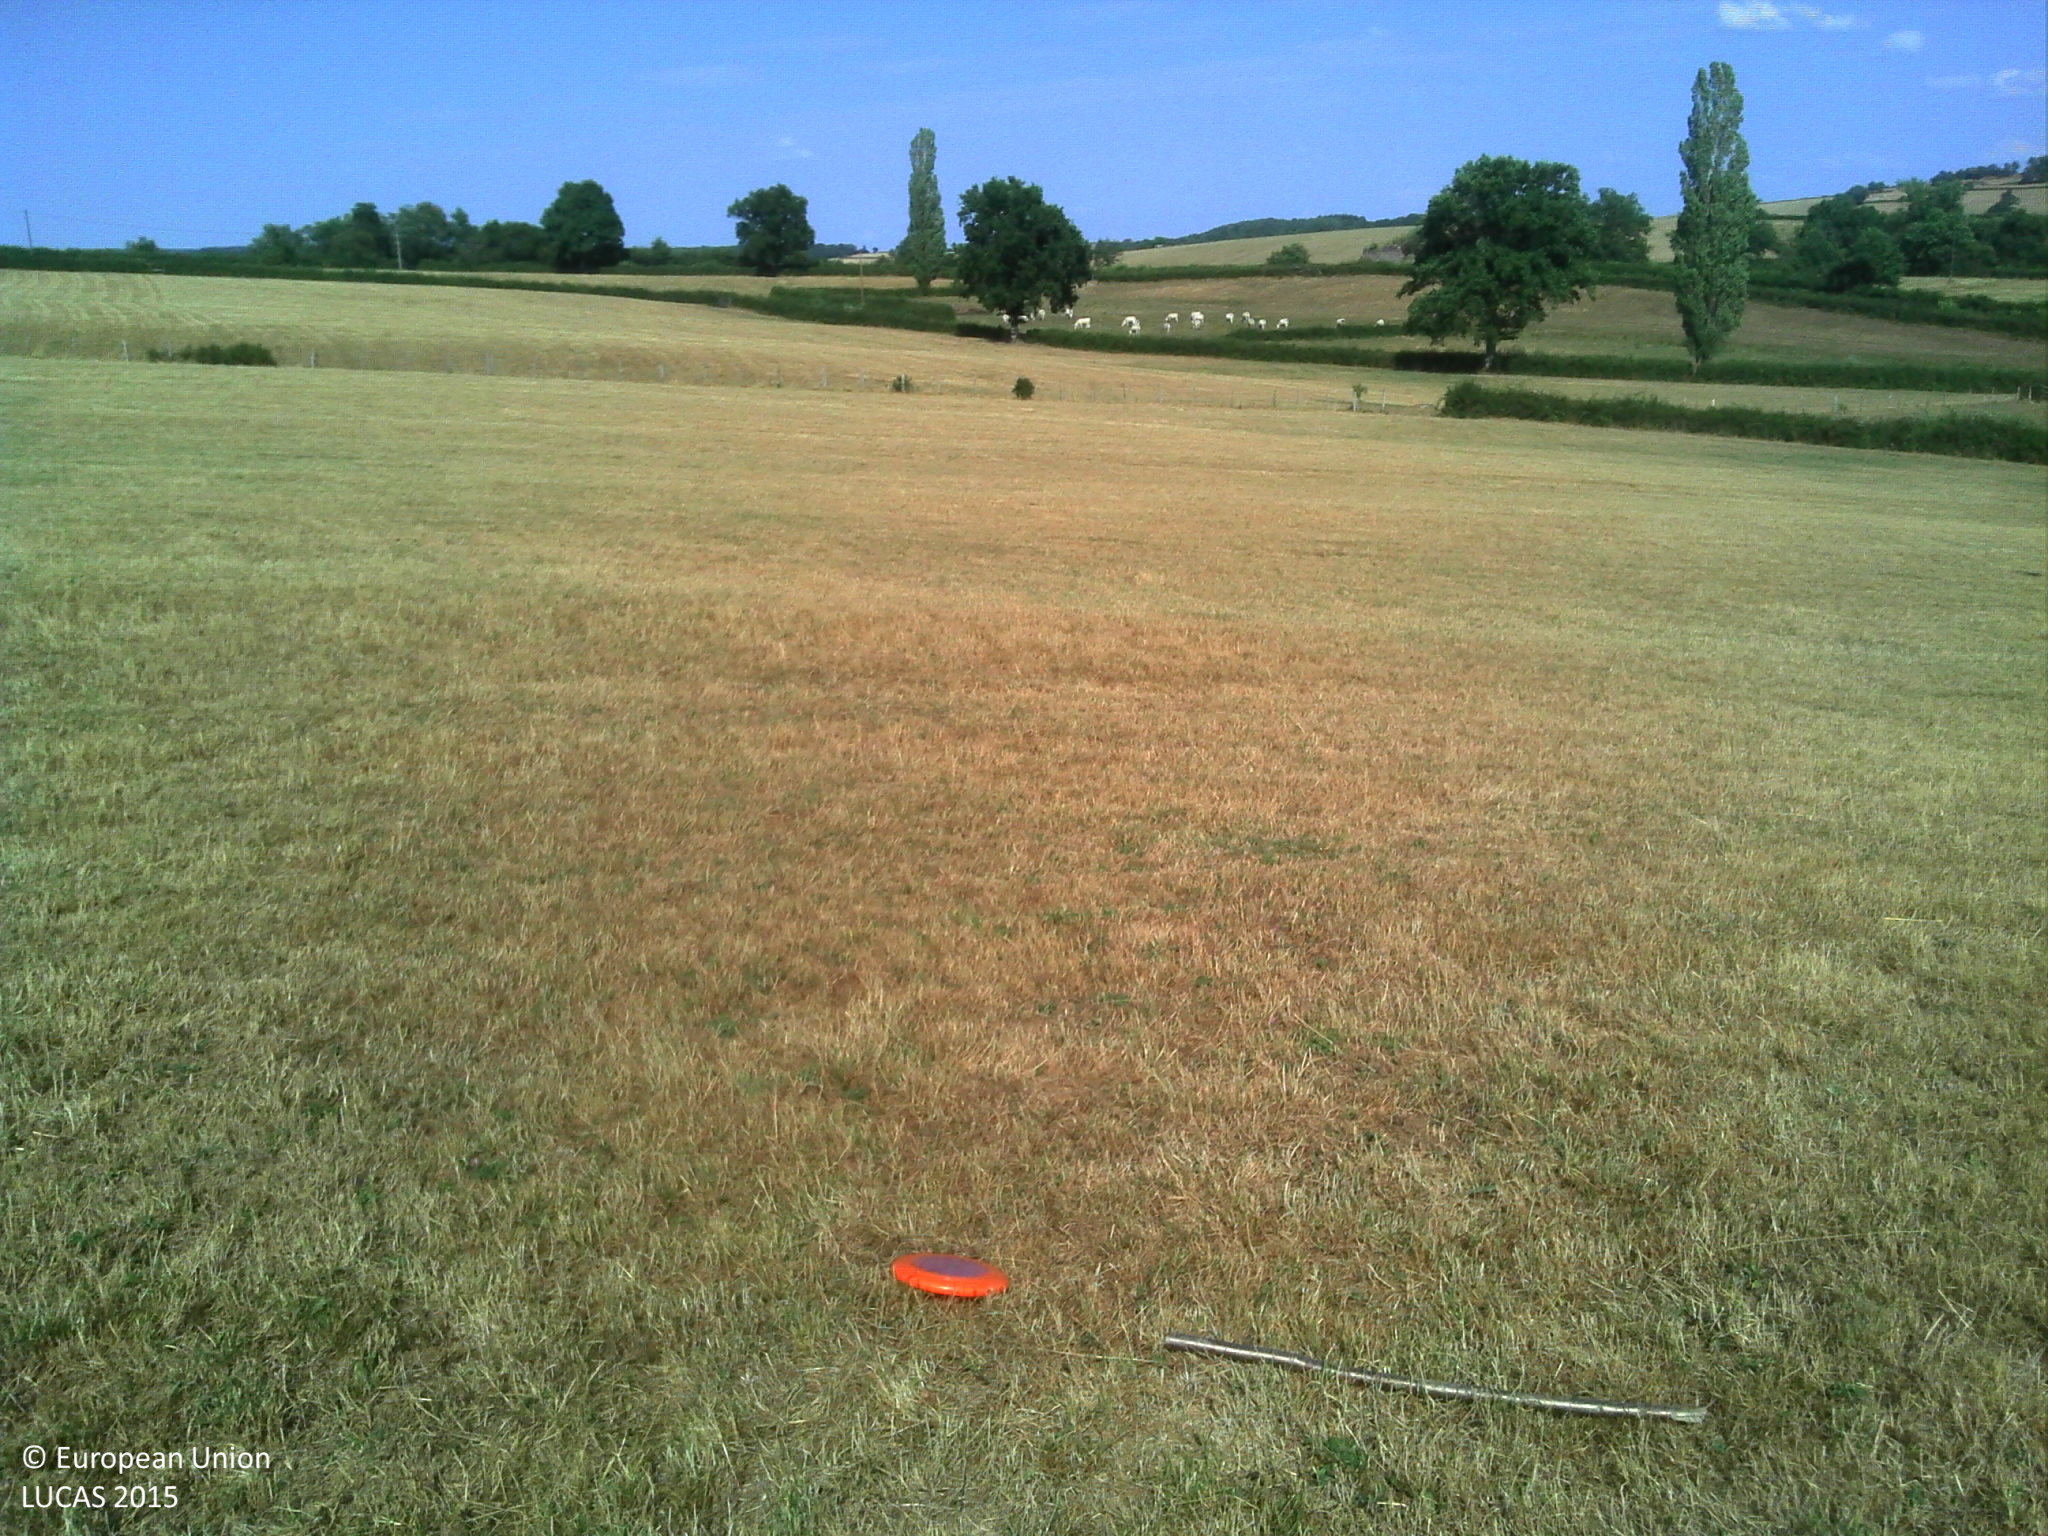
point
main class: Grassland
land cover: Grassland without tree/shrub cover
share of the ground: > 75 %
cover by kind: herbaceous plants 100 %
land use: Agriculture (excluding fallow land and kitchen gardens)
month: July
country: FR
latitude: 46.5837
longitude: 4.4024
